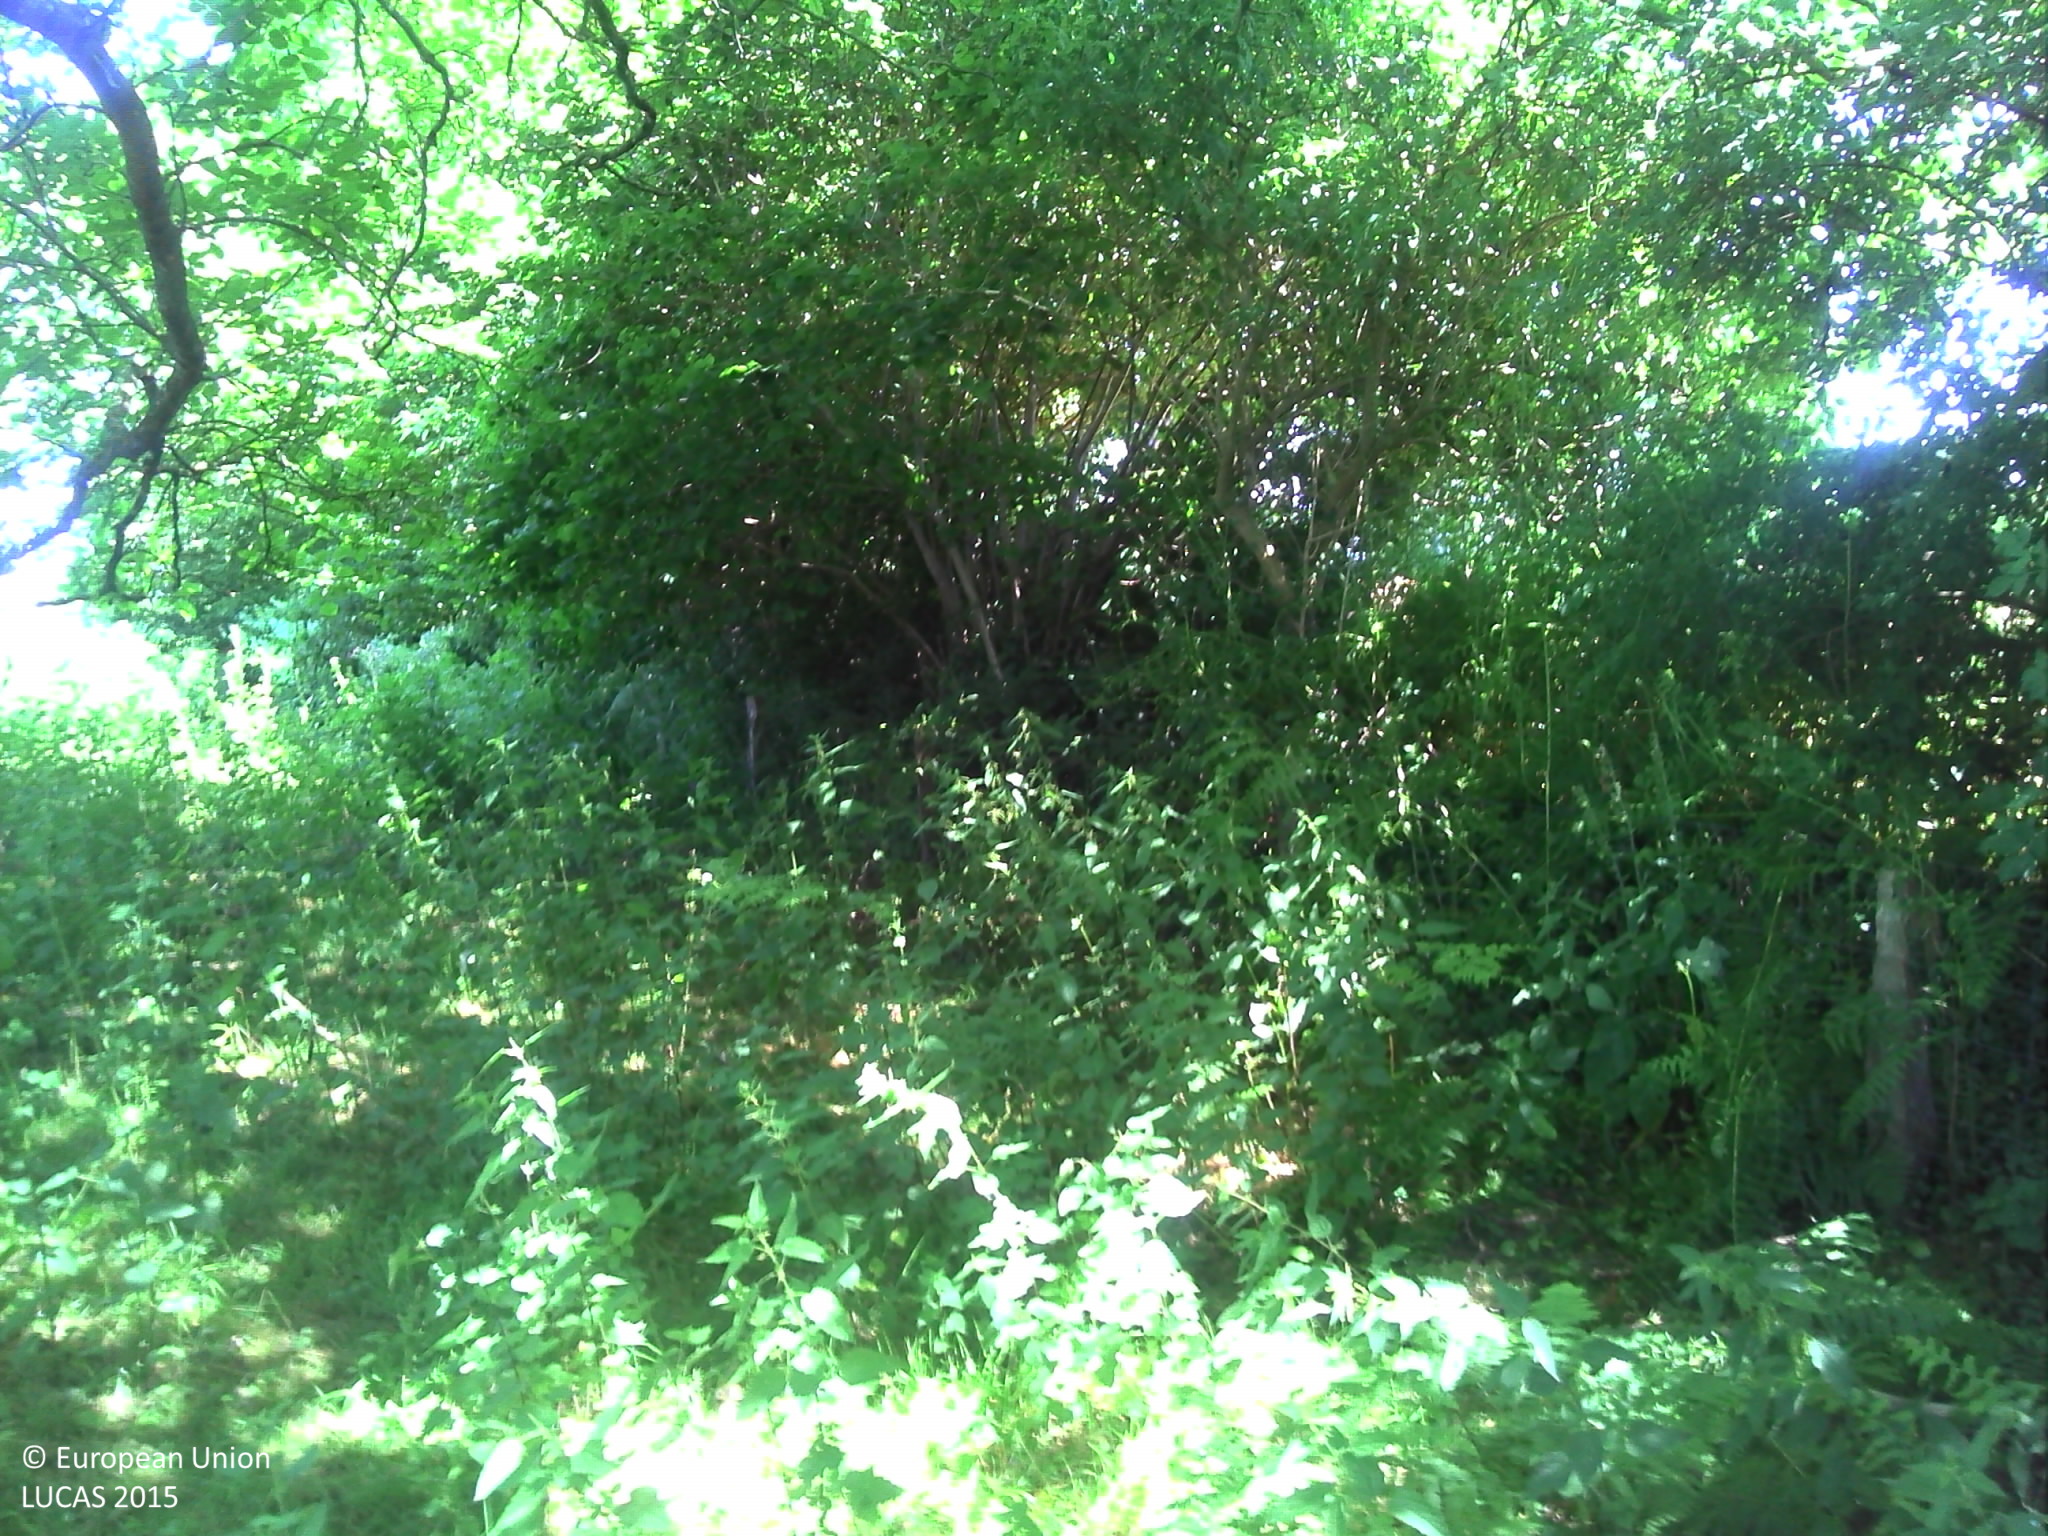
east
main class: Cropland
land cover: Nuts trees
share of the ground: > 75 %
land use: Agriculture (excluding fallow land and kitchen gardens)
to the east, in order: Nuts trees; Abandoned hedges; Barley; Broadleaved woodland; Tracks; Fences; Grassland without tree/shrub cover; Spontaneously vegetated surfaces; Broadleaved woodland
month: July
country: FR
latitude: 49.0510
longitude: -1.3624
